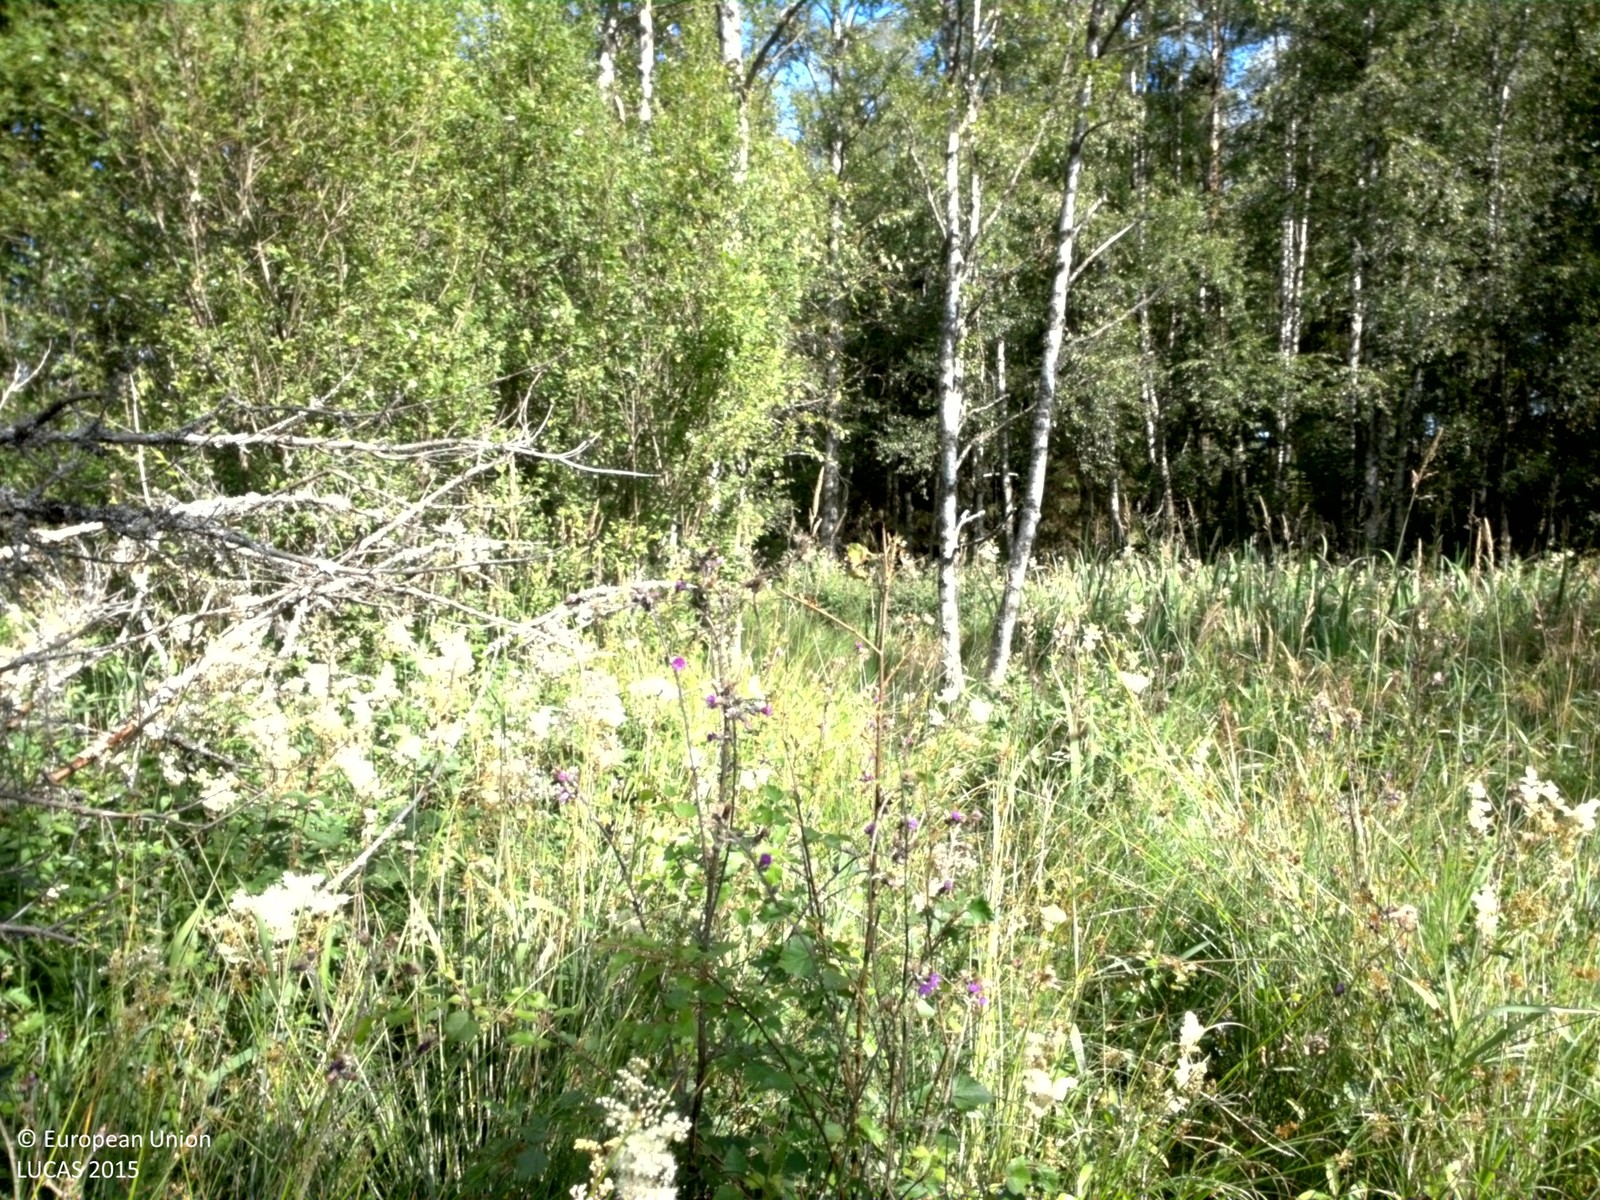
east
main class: Woodland
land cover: Spruce dominated mixed woodland
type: boreal forest
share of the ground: 25 - 50 %
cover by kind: herbaceous plants 70 %, coniferous forest trees 15 %, broadleaved forest trees 15 %
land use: Agriculture (excluding fallow land and kitchen gardens)
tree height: > 5 m
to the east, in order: Spruce dominated mixed woodland; Broadleaved woodland; Electric lines; Broadleaved woodland; Grass margins; Fences; Grass margins; Ditches and canals; Paved roads, cycling and walking lanes; Ditches and canals; Grassland without tree/shrub cover; Electric lines; Grassland with sparse tree/shrub cover; Ditches and canals; Grassland without tree/shrub cover
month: August
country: SE
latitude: 58.1085
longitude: 13.9146
